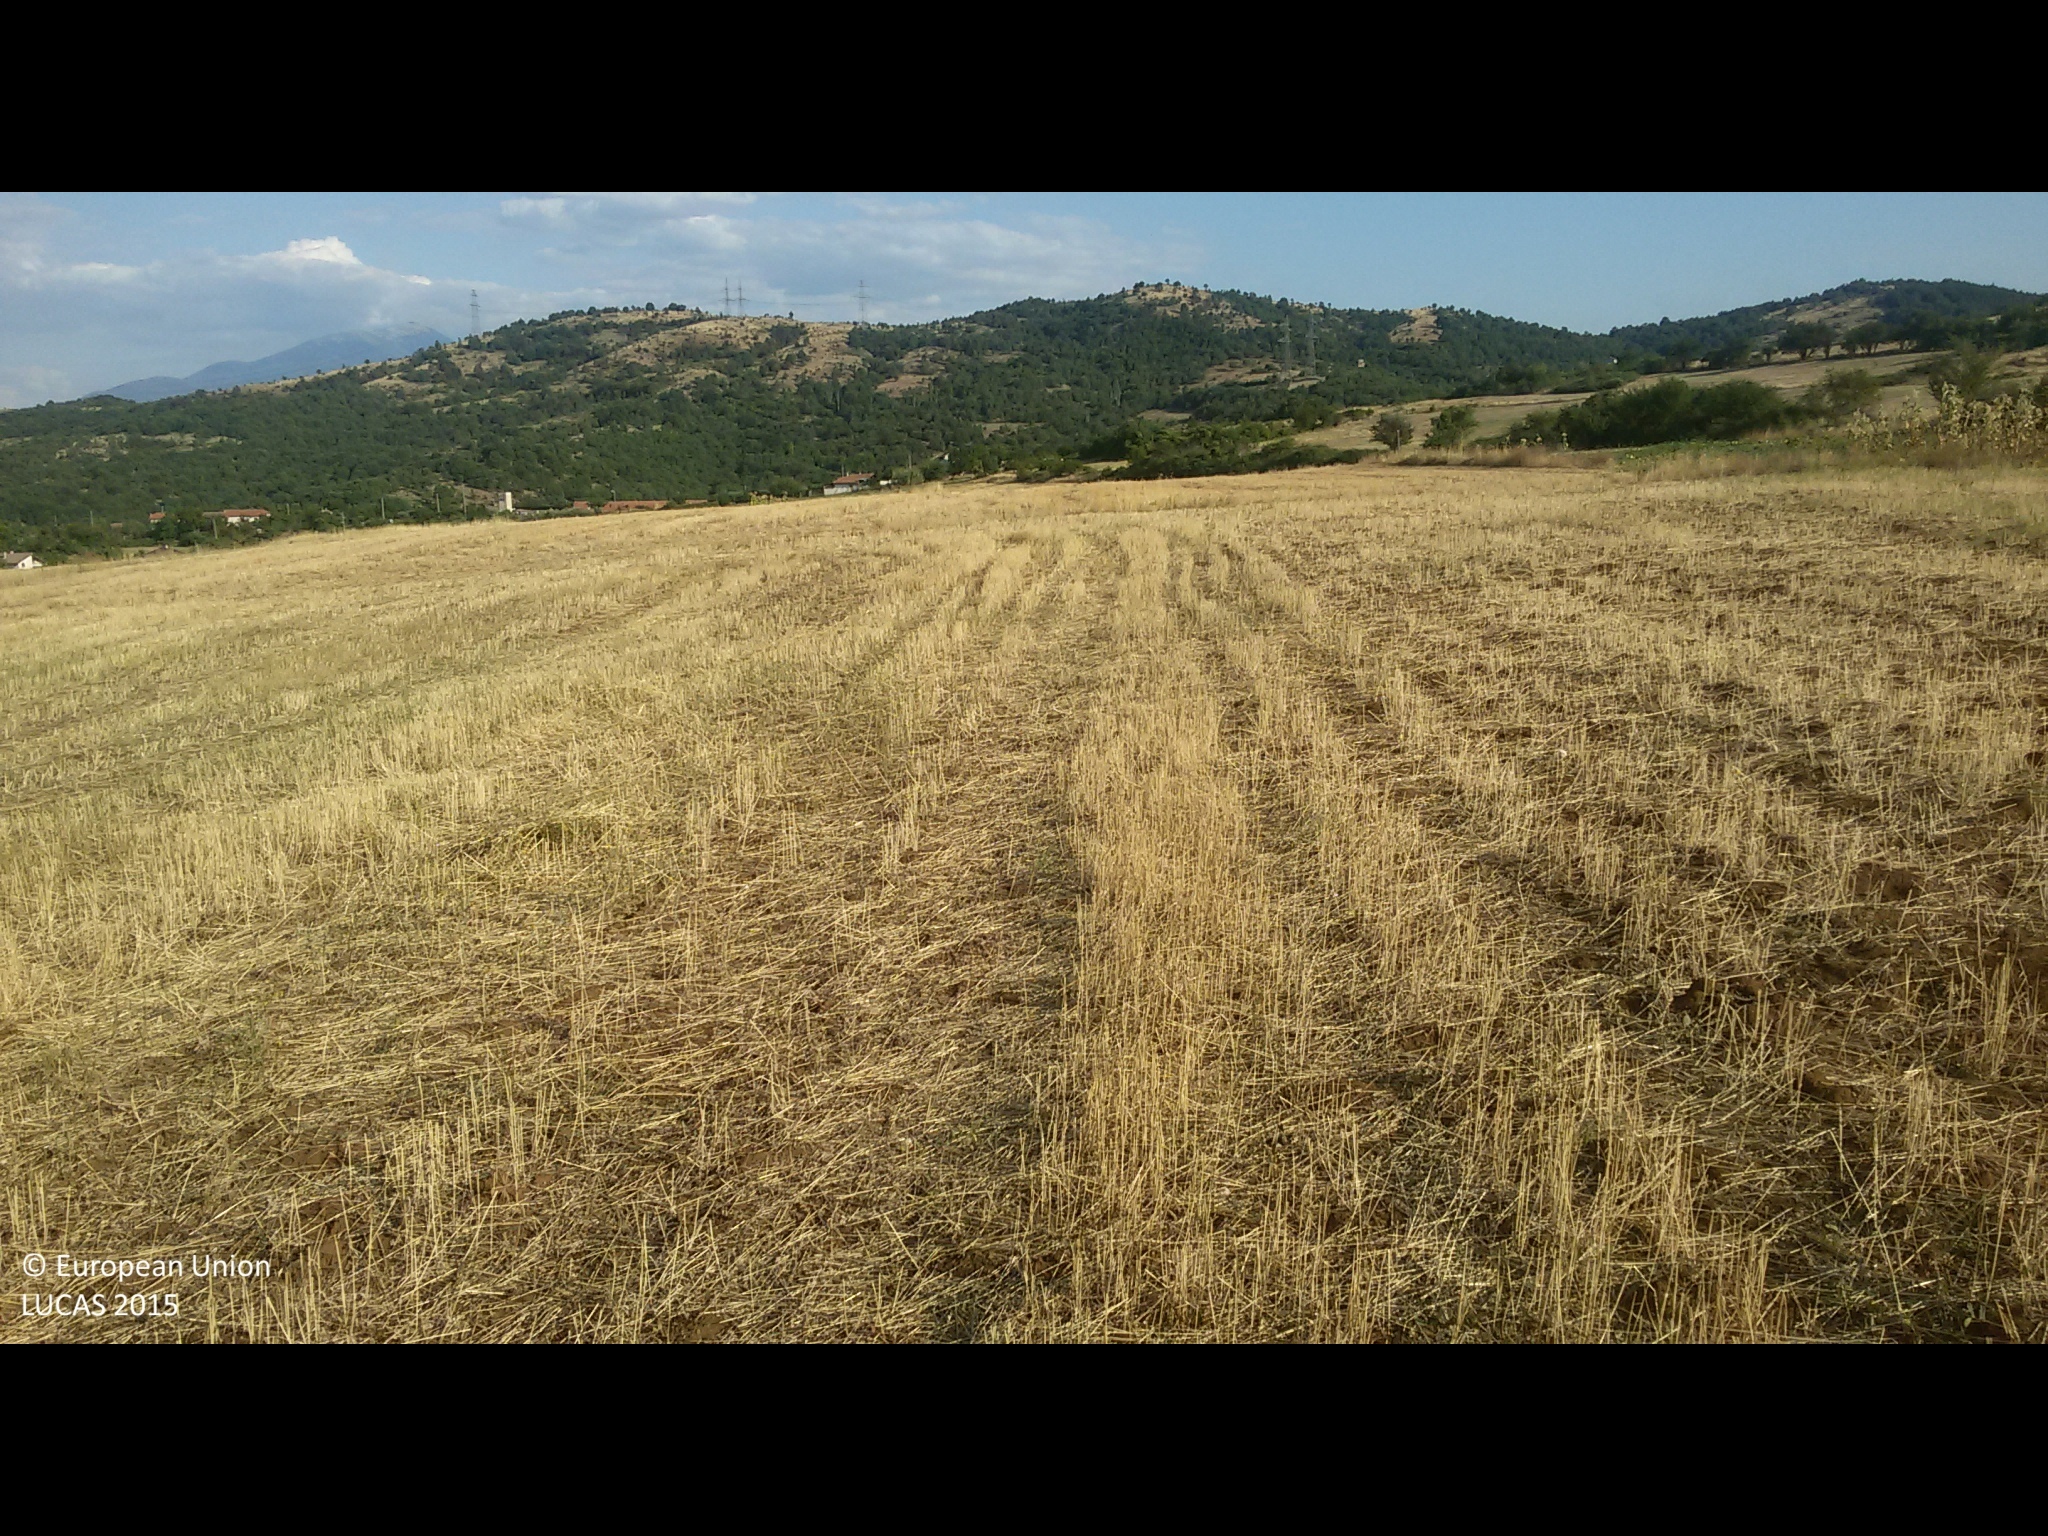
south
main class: Cropland
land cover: Common wheat
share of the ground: 50 - 75 %
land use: Agriculture (excluding fallow land and kitchen gardens)
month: August
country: BG
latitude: 41.9679
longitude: 23.0675
